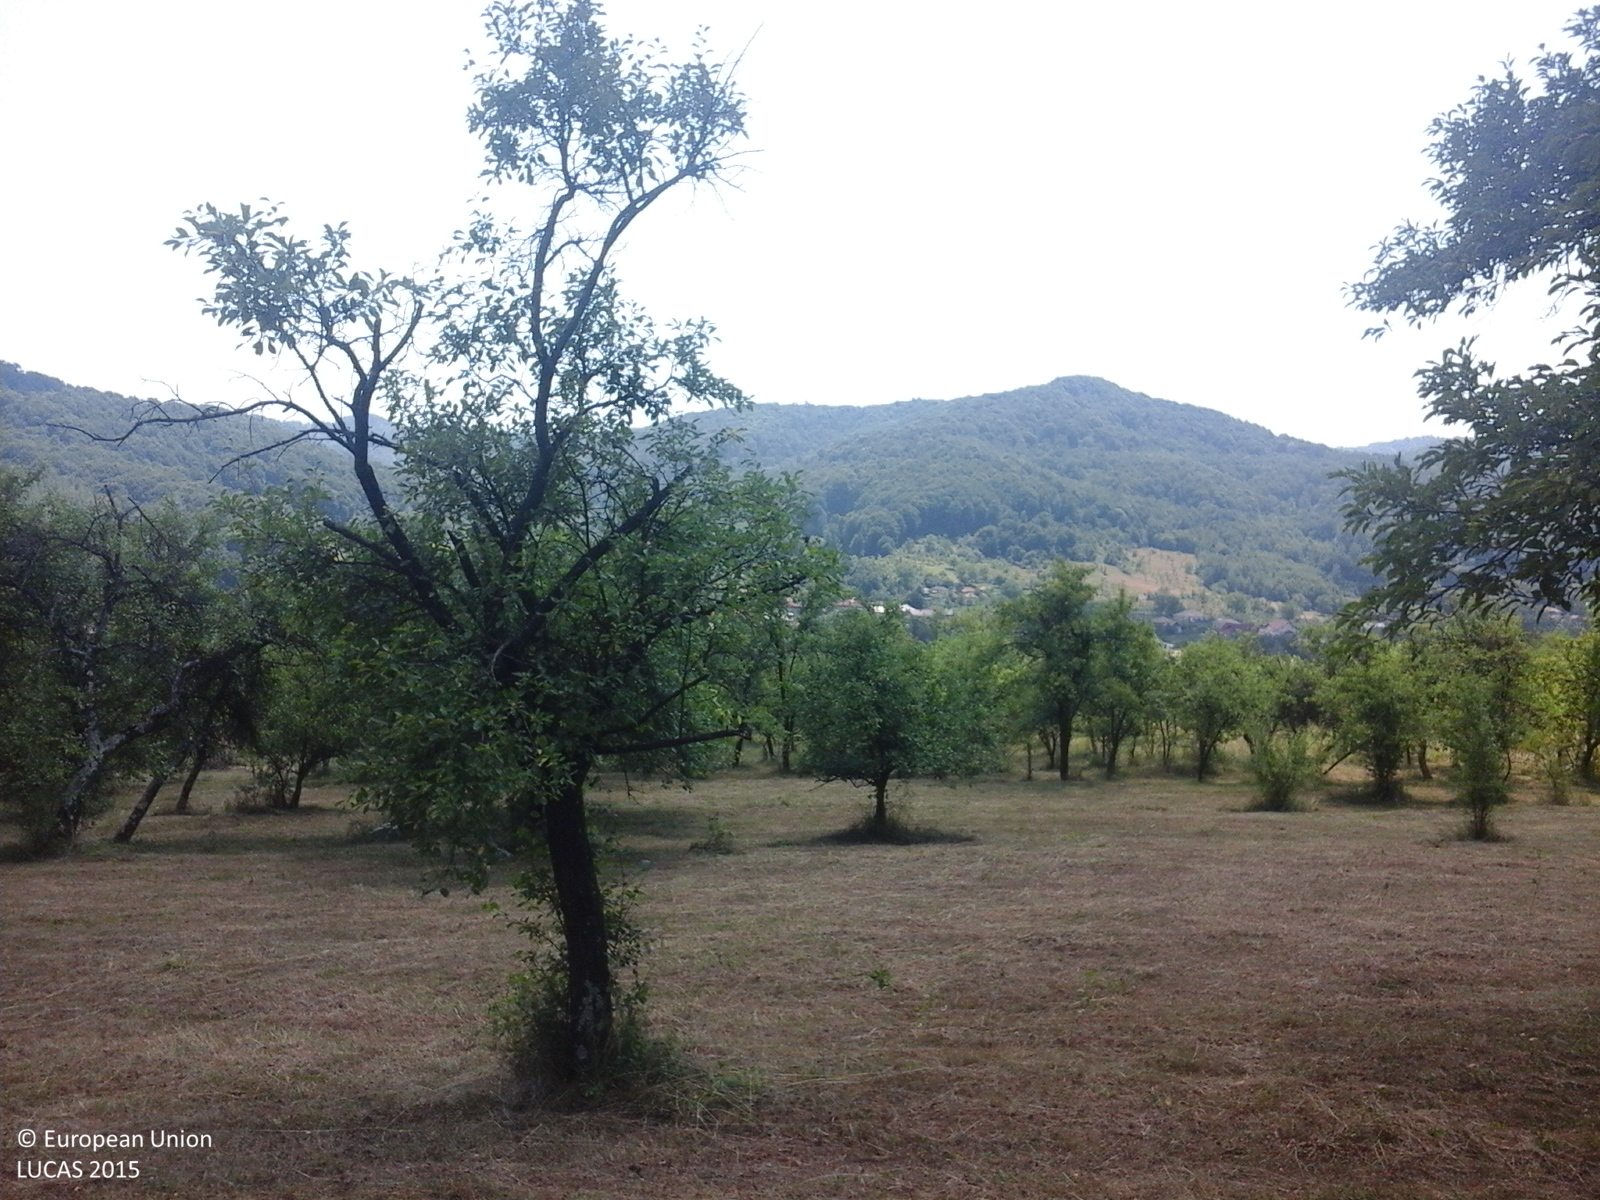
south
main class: Cropland
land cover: Other fruit trees and berries
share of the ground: 25 - 50 %
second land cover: Grassland without tree/shrub cover
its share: > 75 %
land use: Agriculture (excluding fallow land and kitchen gardens)
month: July
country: RO
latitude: 45.0723
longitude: 24.4407
